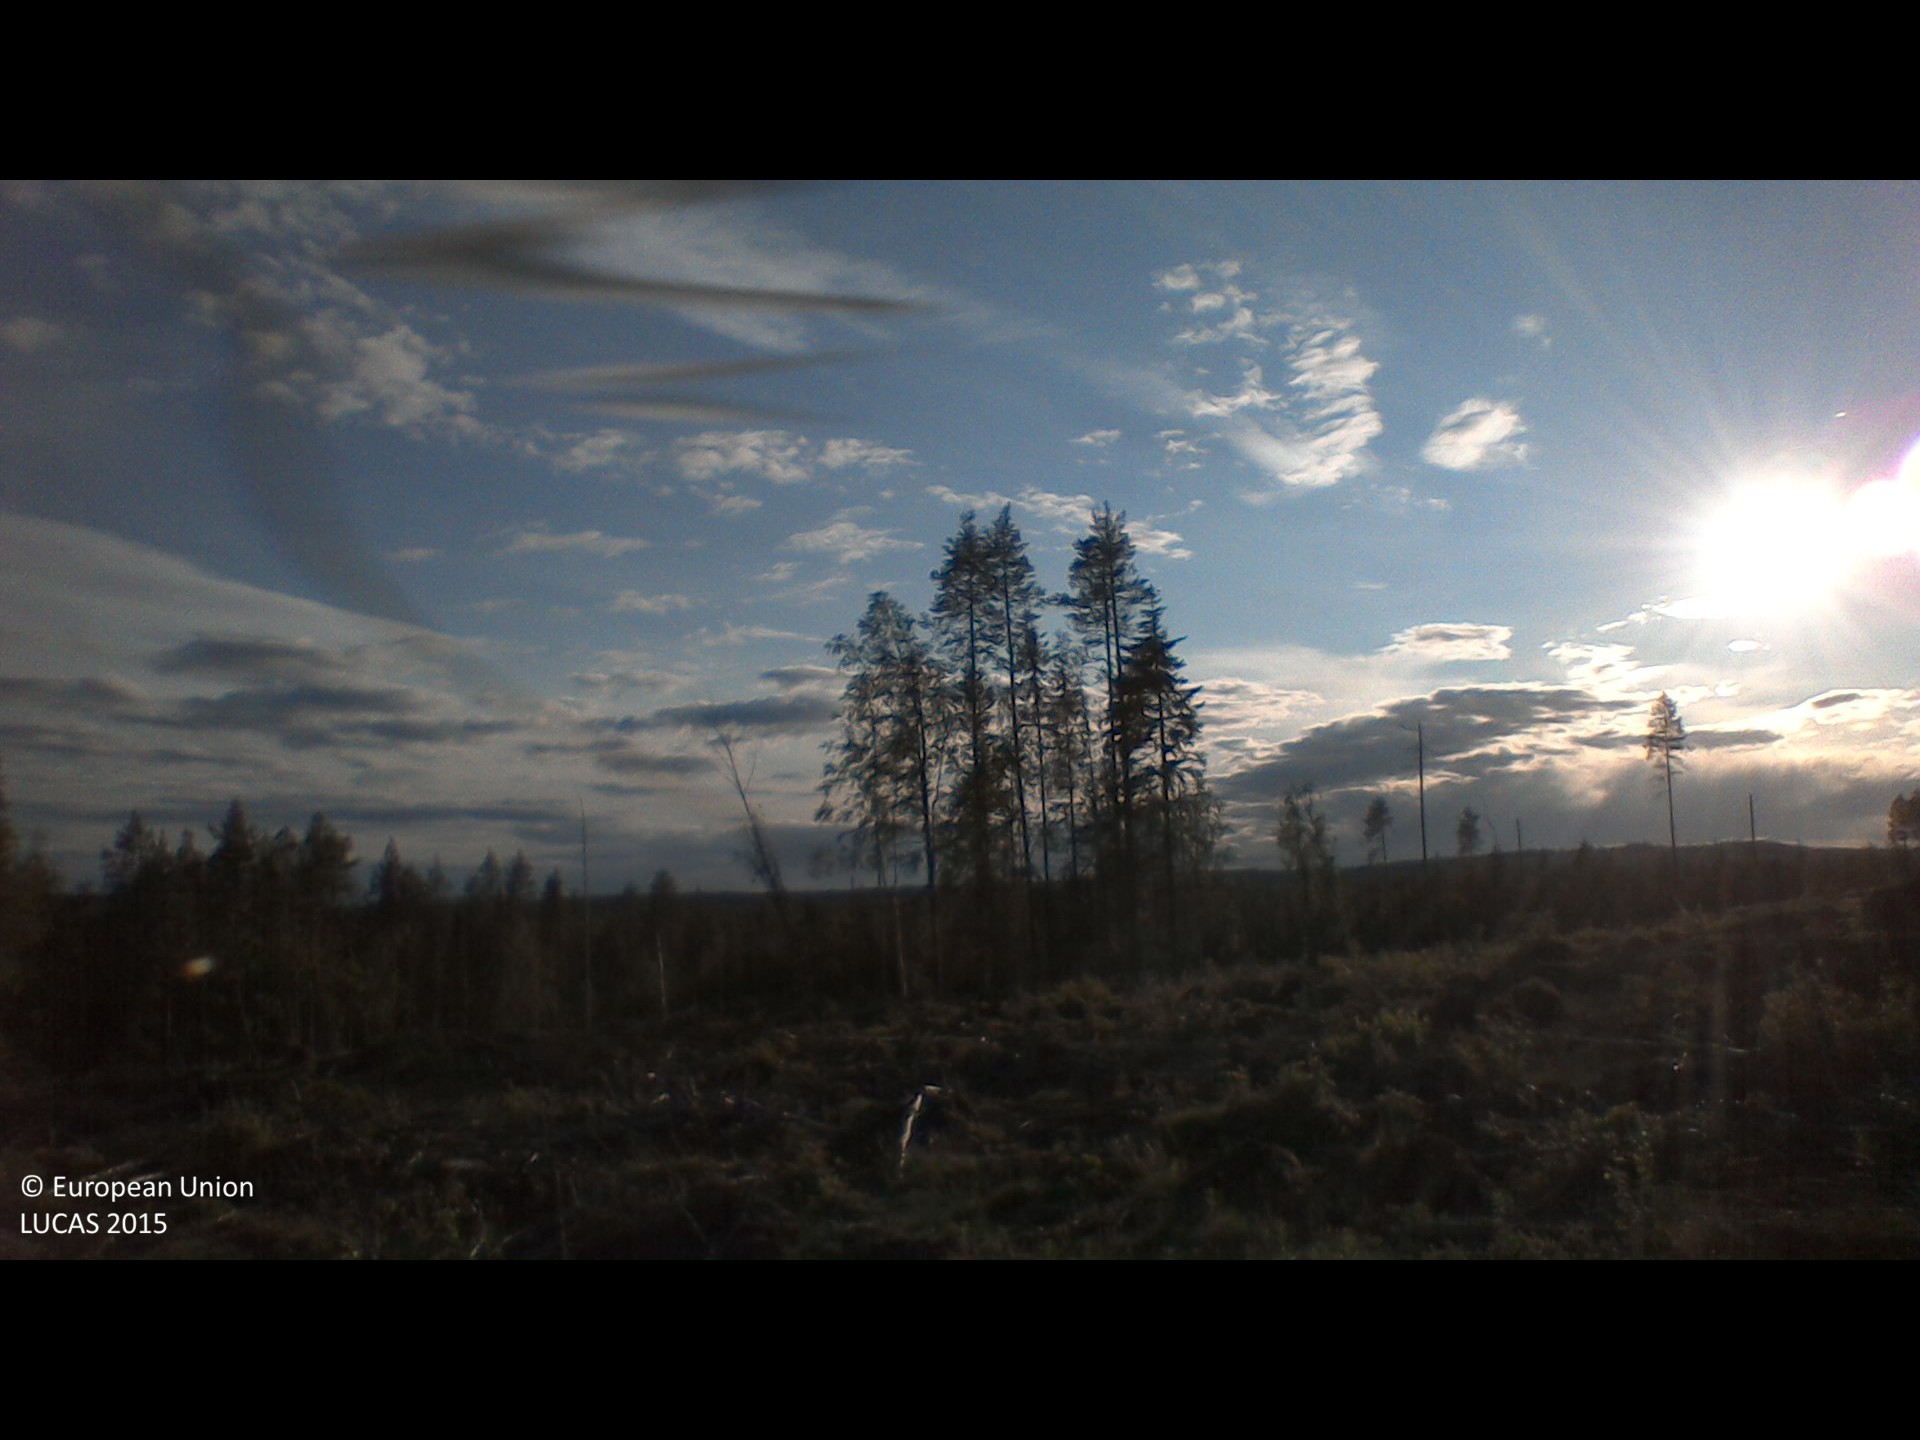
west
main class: Shrubland
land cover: Shrubland with sparse tree cover
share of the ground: 10 - 25 %
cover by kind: unconsolidated bare surface 45 %, shrubs 25 %, herbaceous plants 25 %, broadleaved forest trees 5 %
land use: Forestry
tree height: < 5 m
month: July
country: SE
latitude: 66.8864
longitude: 23.0994
